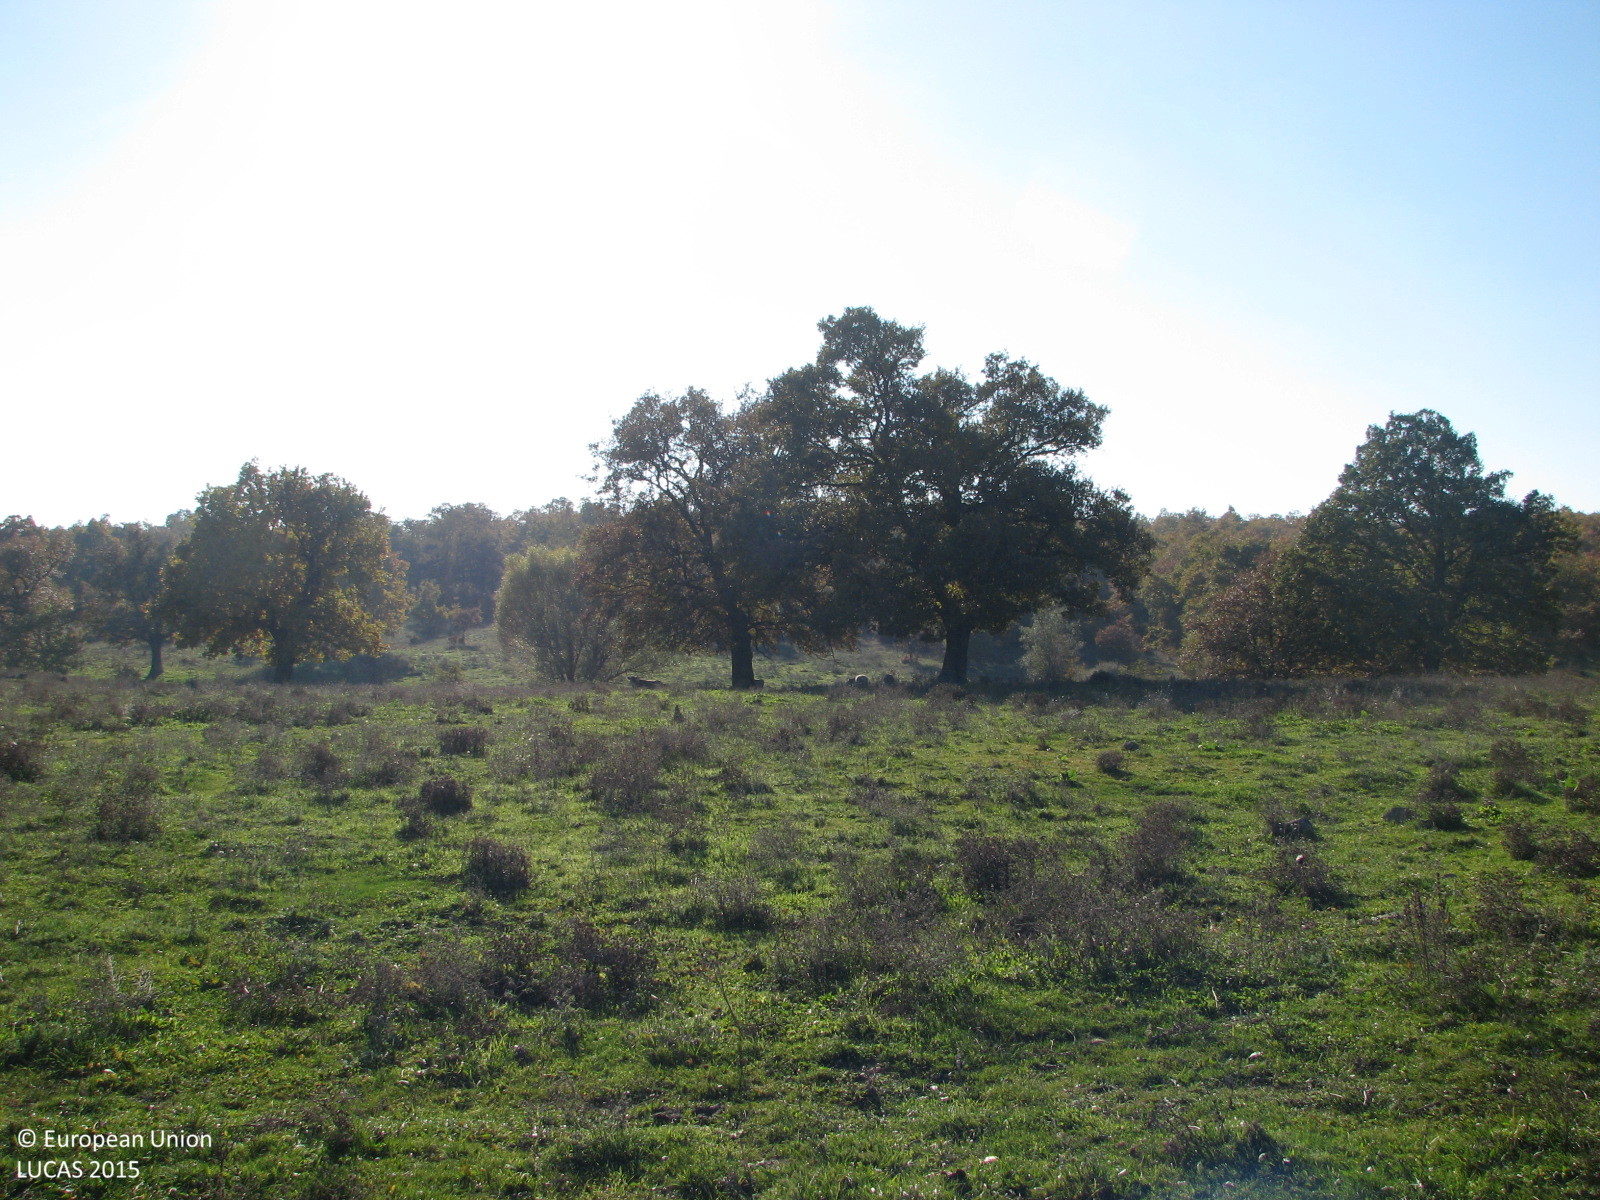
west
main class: Grassland
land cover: Grassland without tree/shrub cover
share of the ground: > 75 %
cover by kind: herbaceous plants 100 %
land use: Agriculture (excluding fallow land and kitchen gardens)
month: November
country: BG
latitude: 42.0659
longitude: 26.8079
